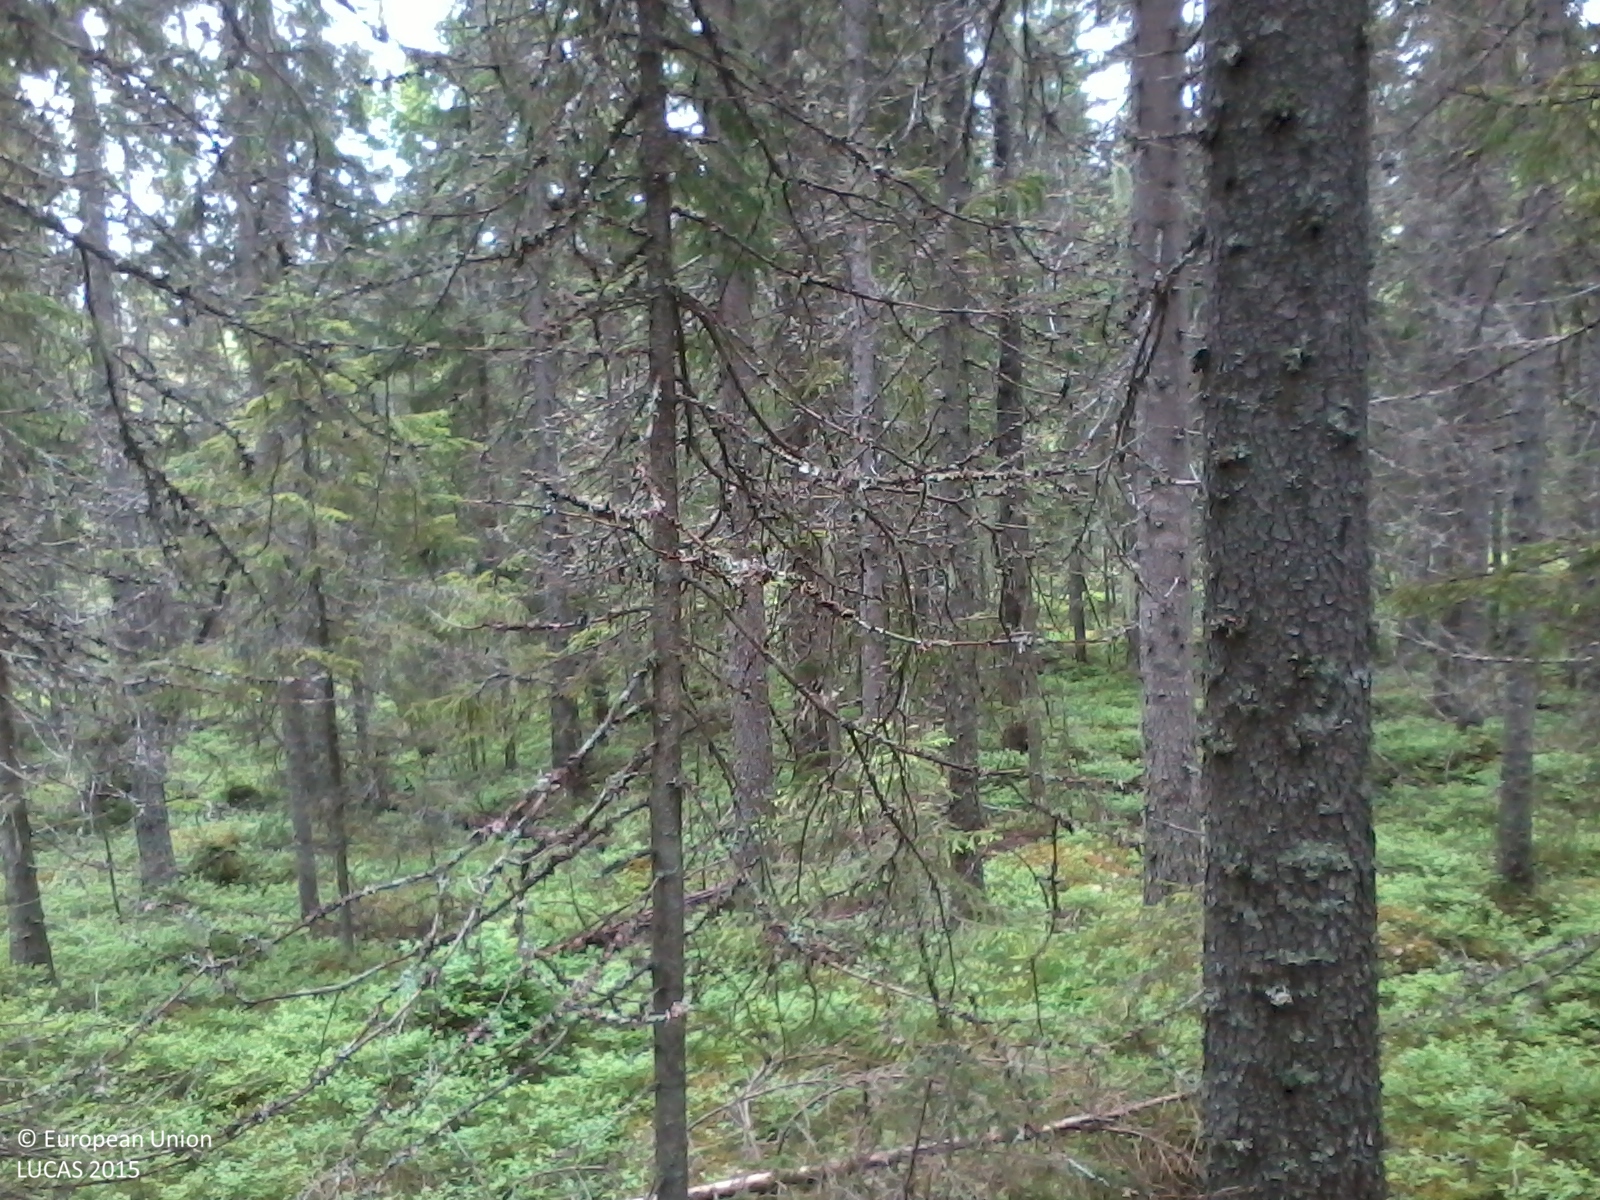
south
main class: Woodland
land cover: Spruce dominated coniferous woodland
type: boreal forest
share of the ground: 50 - 75 %
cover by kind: coniferous forest trees 60 %, shrubs 35 %, broadleaved forest trees 5 %
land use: Forestry
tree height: > 5 m
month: June
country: SE
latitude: 63.4888
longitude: 17.9867
